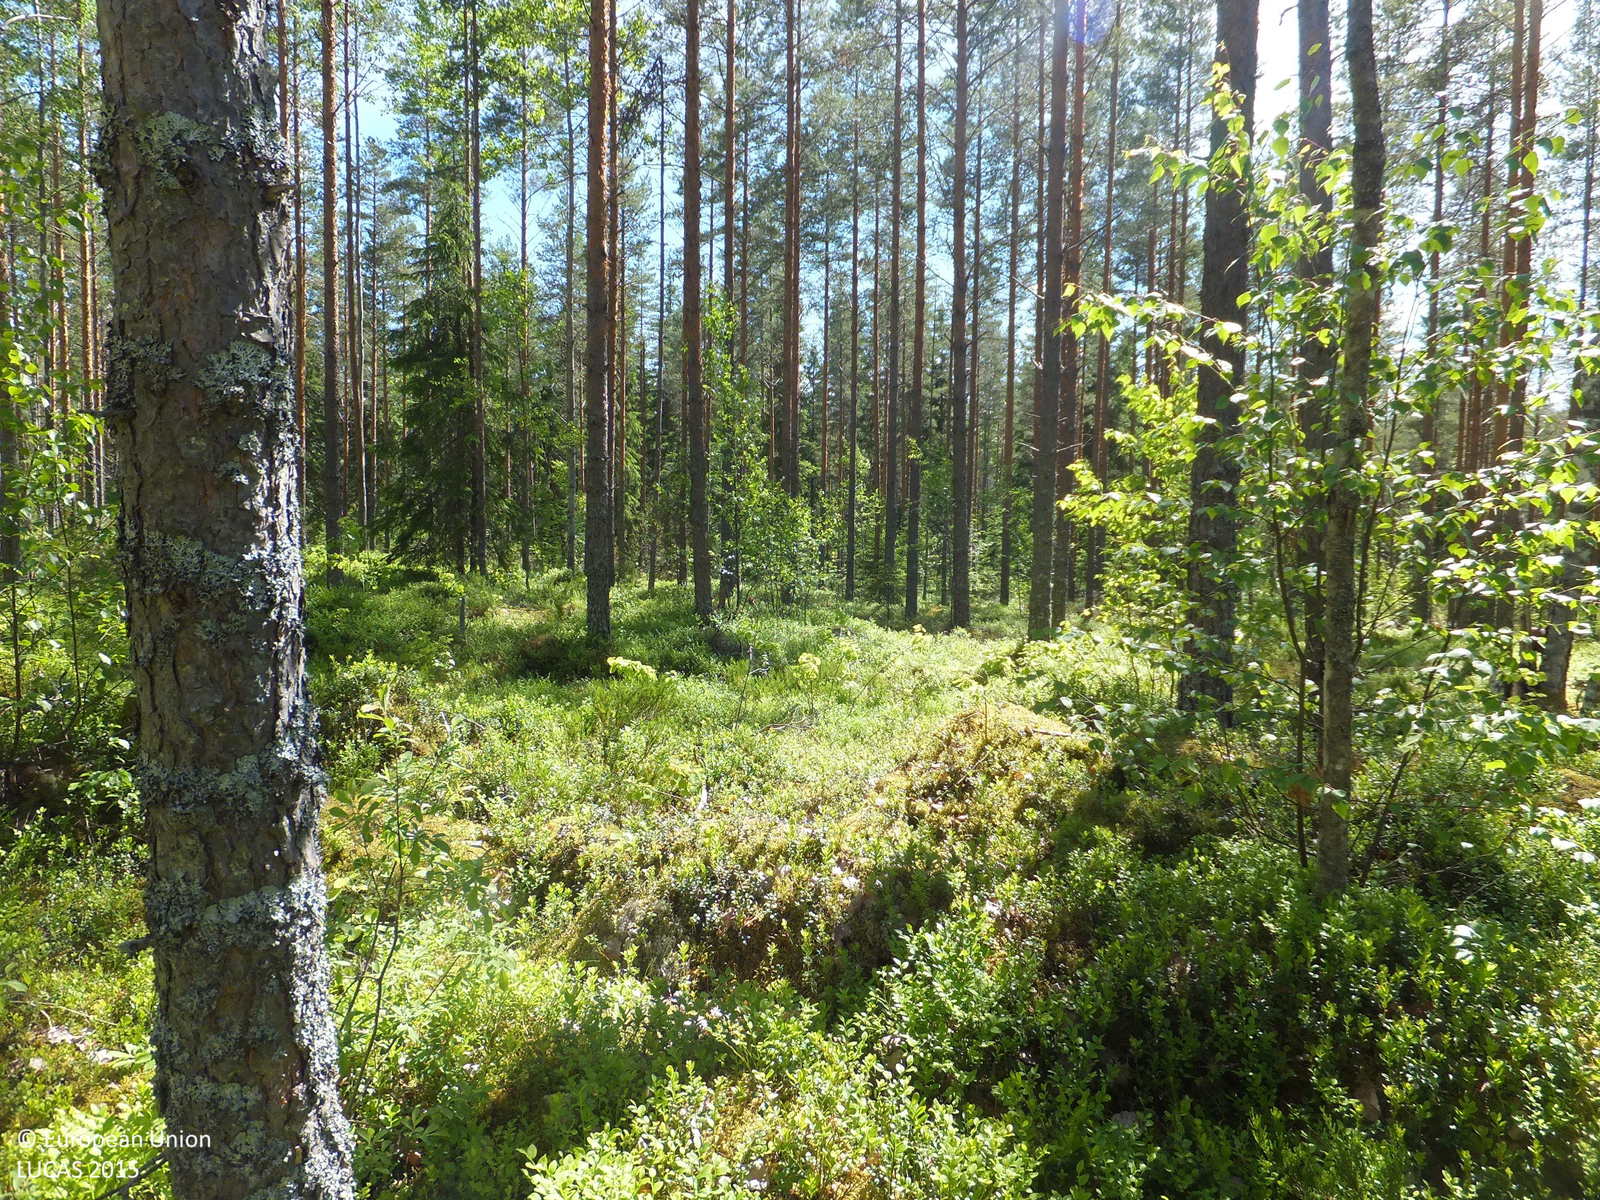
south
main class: Woodland
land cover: Pine dominated mixed woodland
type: boreal forest
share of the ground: 50 - 75 %
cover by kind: coniferous forest trees 40 %, shrubs 25 %, broadleaved forest trees 15 %, lichens and mosses 15 %, consolidated bare surface 5 %
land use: Forestry
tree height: > 5 m
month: July
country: FI
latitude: 63.0439
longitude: 23.9349
